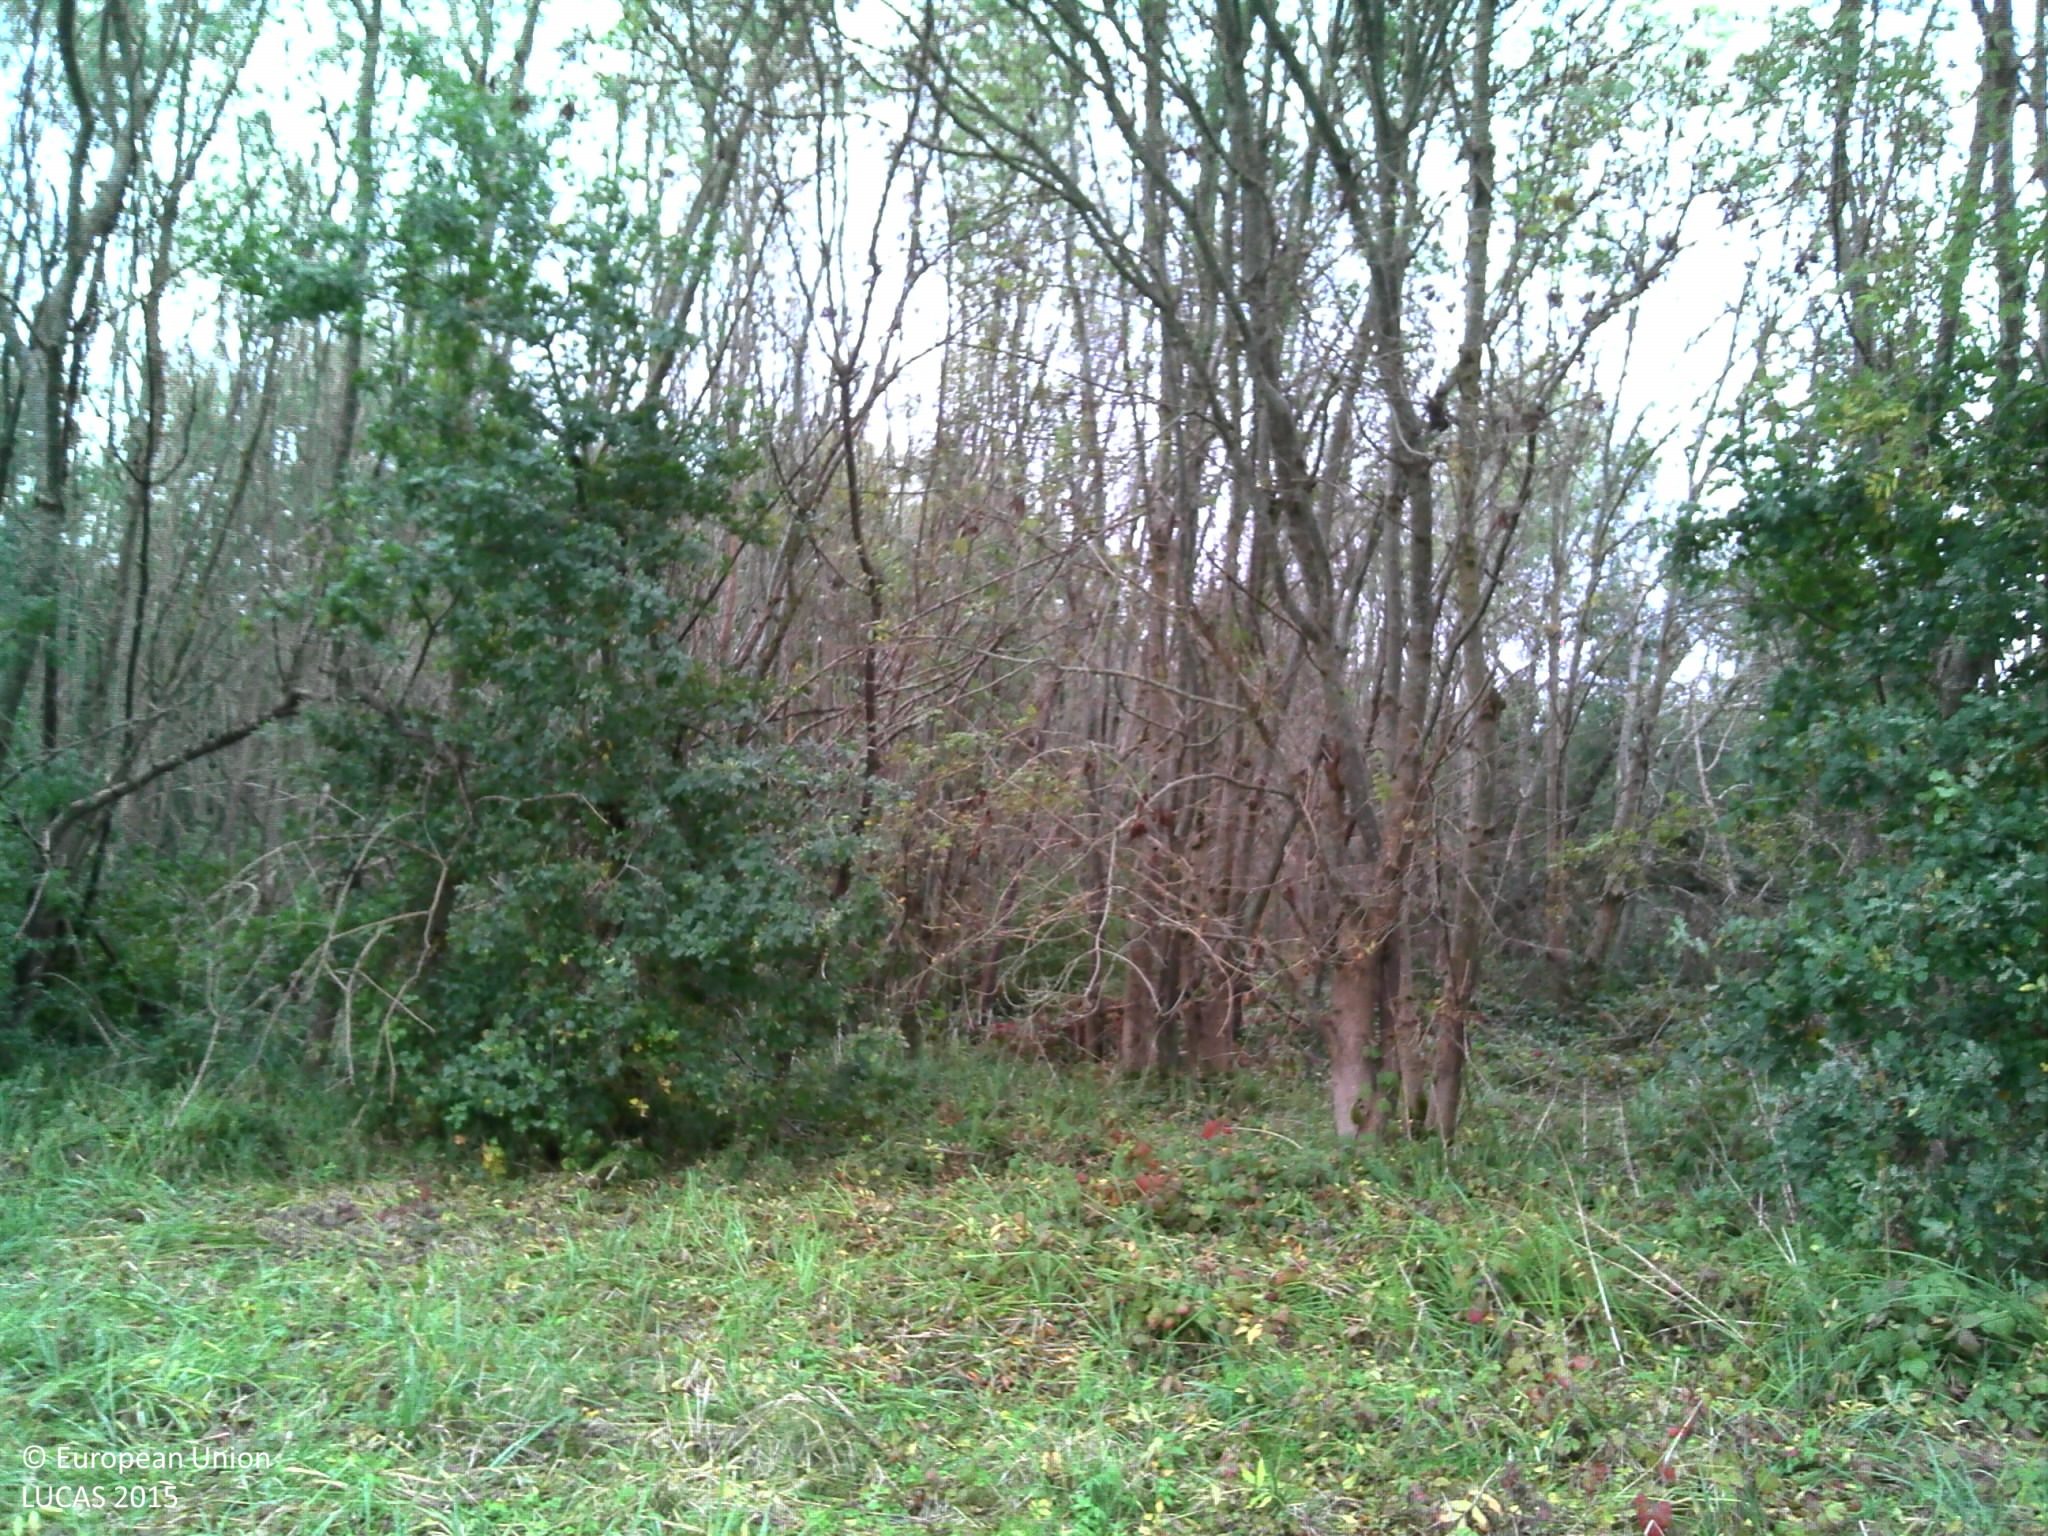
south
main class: Grassland
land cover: Grassland without tree/shrub cover
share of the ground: > 75 %
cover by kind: herbaceous plants 100 %
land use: Agriculture (excluding fallow land and kitchen gardens)
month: October
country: FR
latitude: 46.2070
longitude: 4.8052
